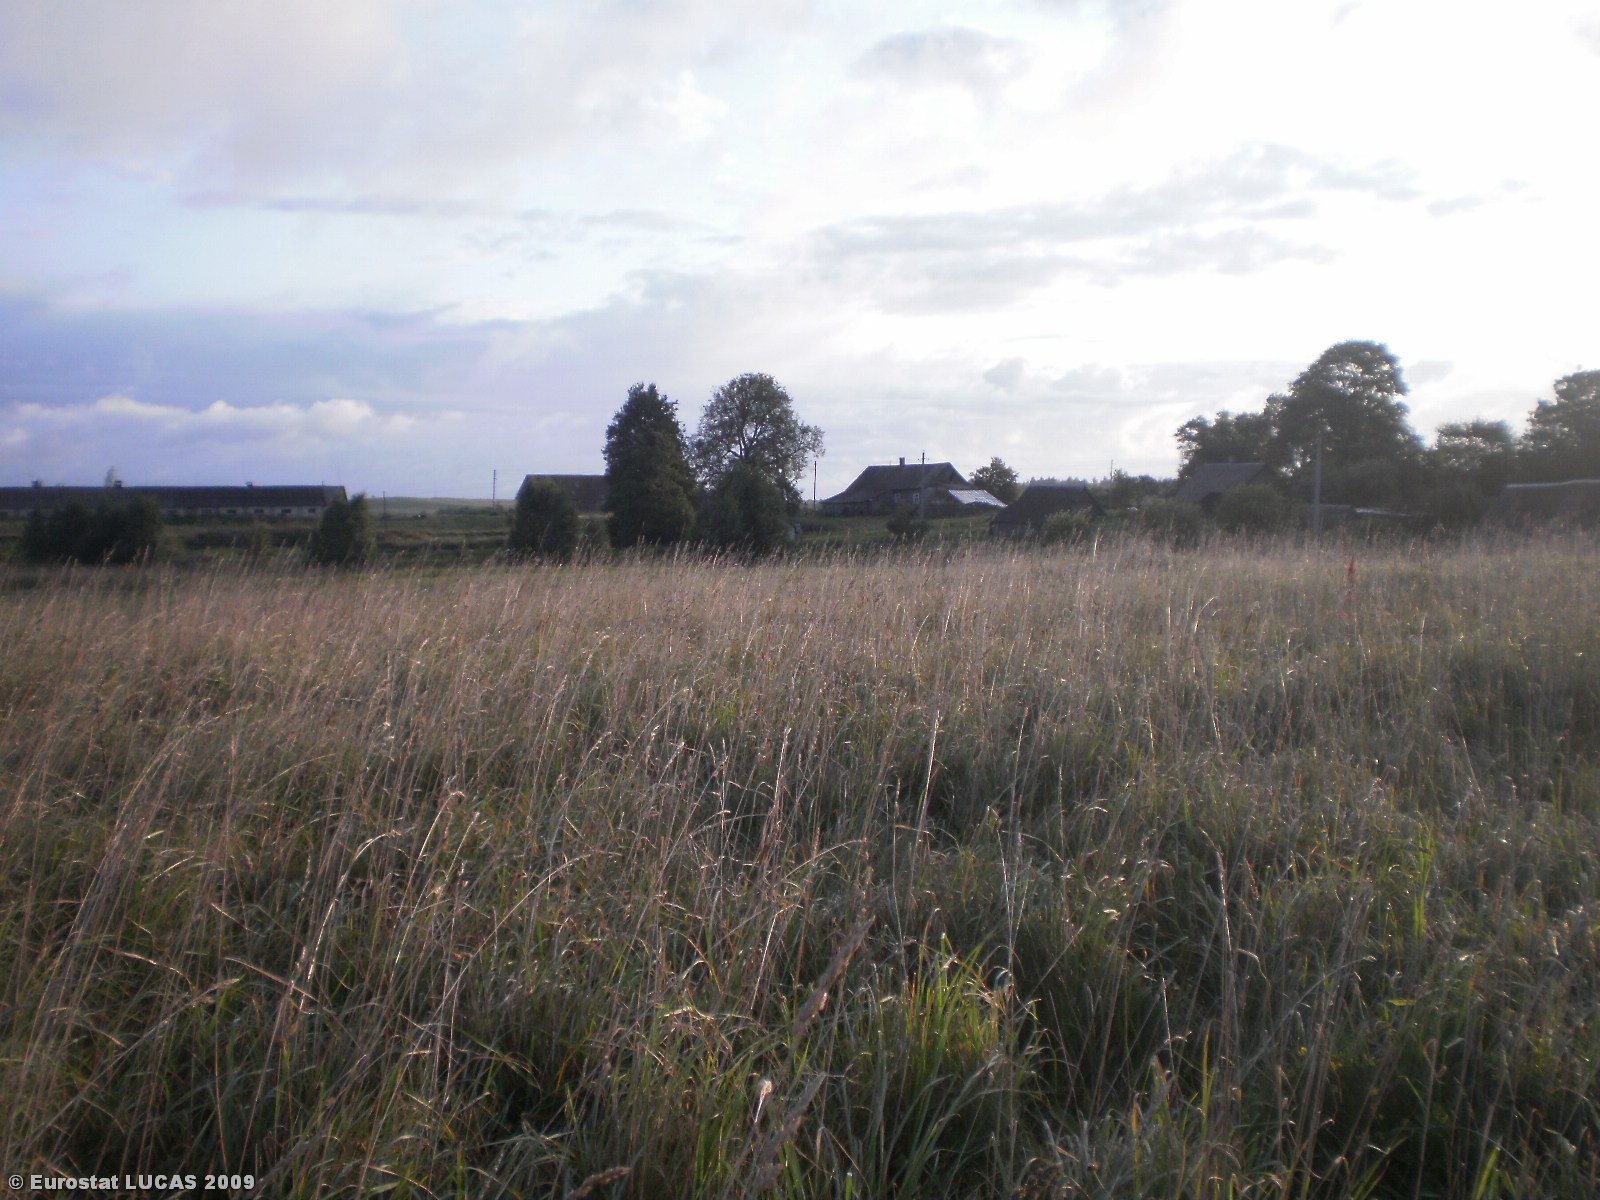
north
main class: Grassland
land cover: Grassland without tree/shrub cover
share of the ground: > 75 %
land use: Agriculture (excluding fallow land and kitchen gardens)
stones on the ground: 10 - 25 %
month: August
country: LT
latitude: 55.0949
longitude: 25.4658
